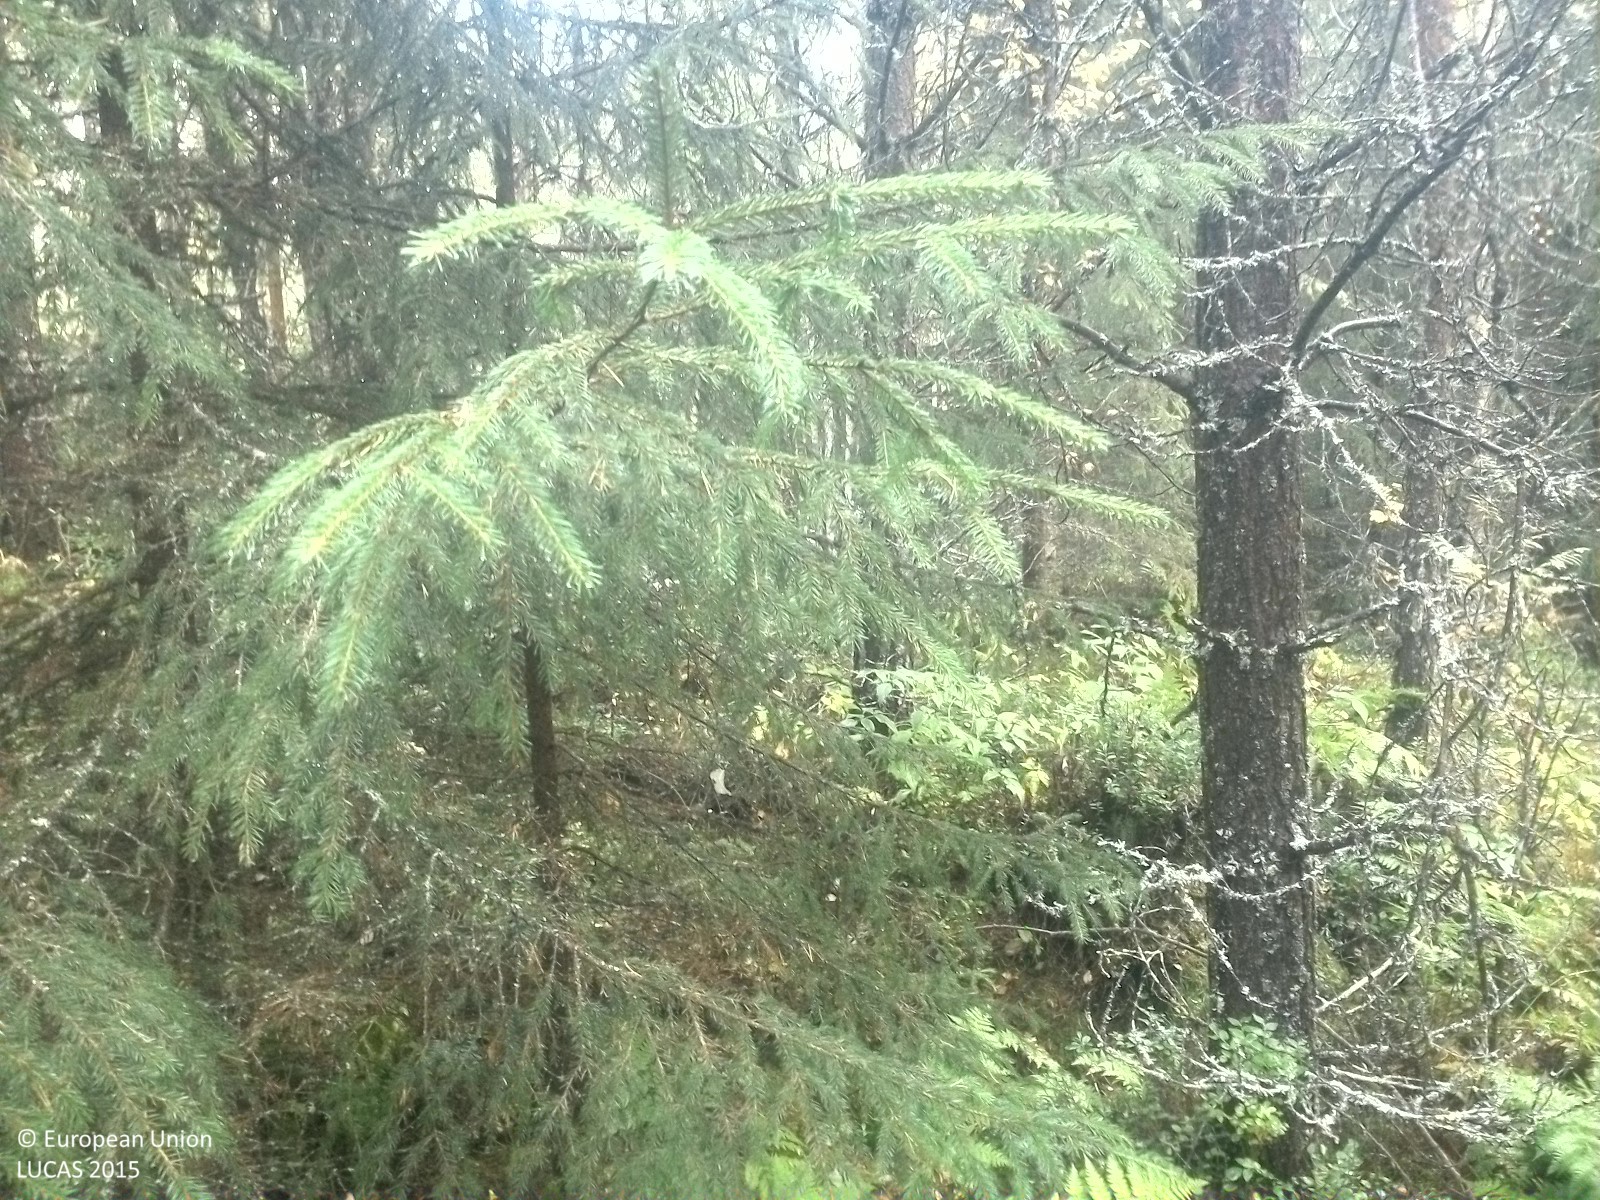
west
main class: Woodland
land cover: Other mixed woodland
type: boreal forest
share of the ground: 50 - 75 %
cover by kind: coniferous forest trees 40 %, lichens and mosses 20 %, broadleaved forest trees 15 %, herbaceous plants 15 %, shrubs 10 %
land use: Forestry
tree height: > 5 m
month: September
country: SE
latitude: 62.1301
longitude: 15.5614
